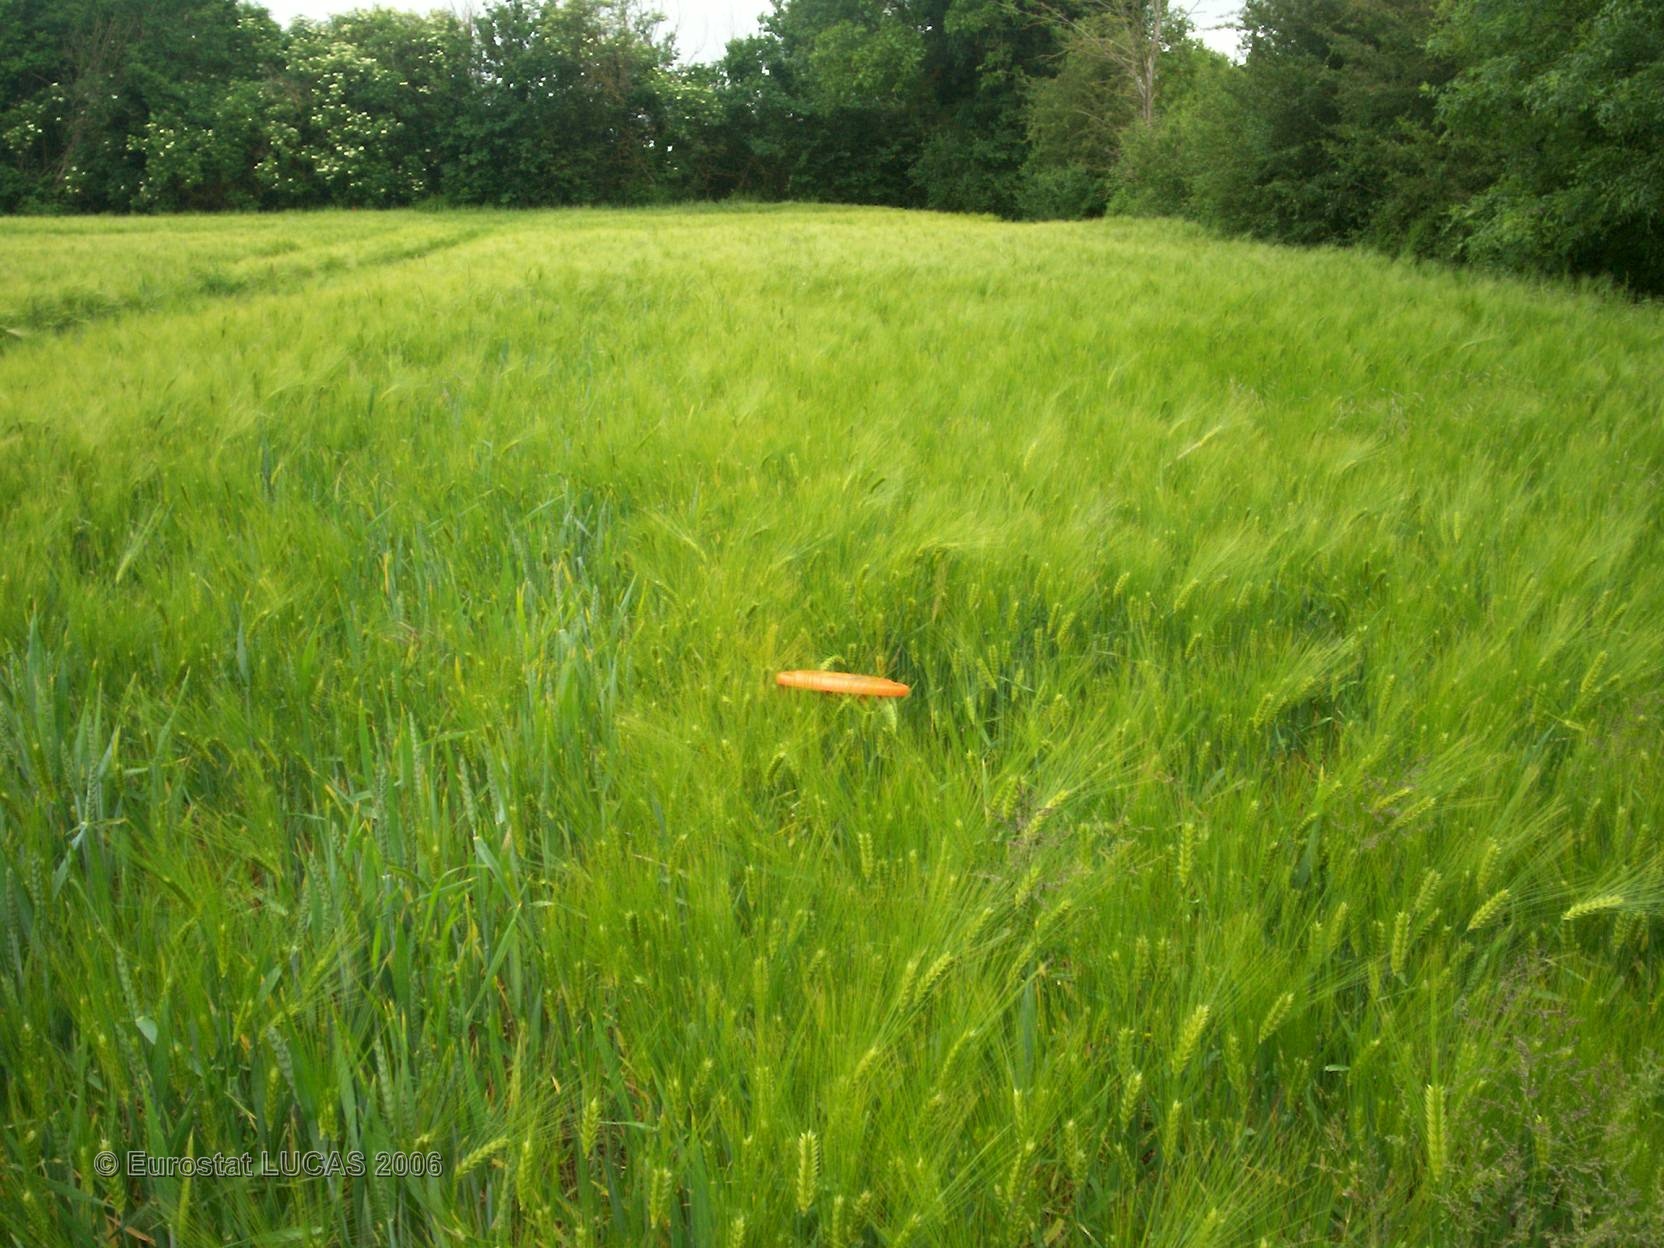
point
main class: Cropland
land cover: Barley
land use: Agriculture (excluding fallow land and kitchen gardens)
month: May
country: FR
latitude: 46.2919
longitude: 0.5206
